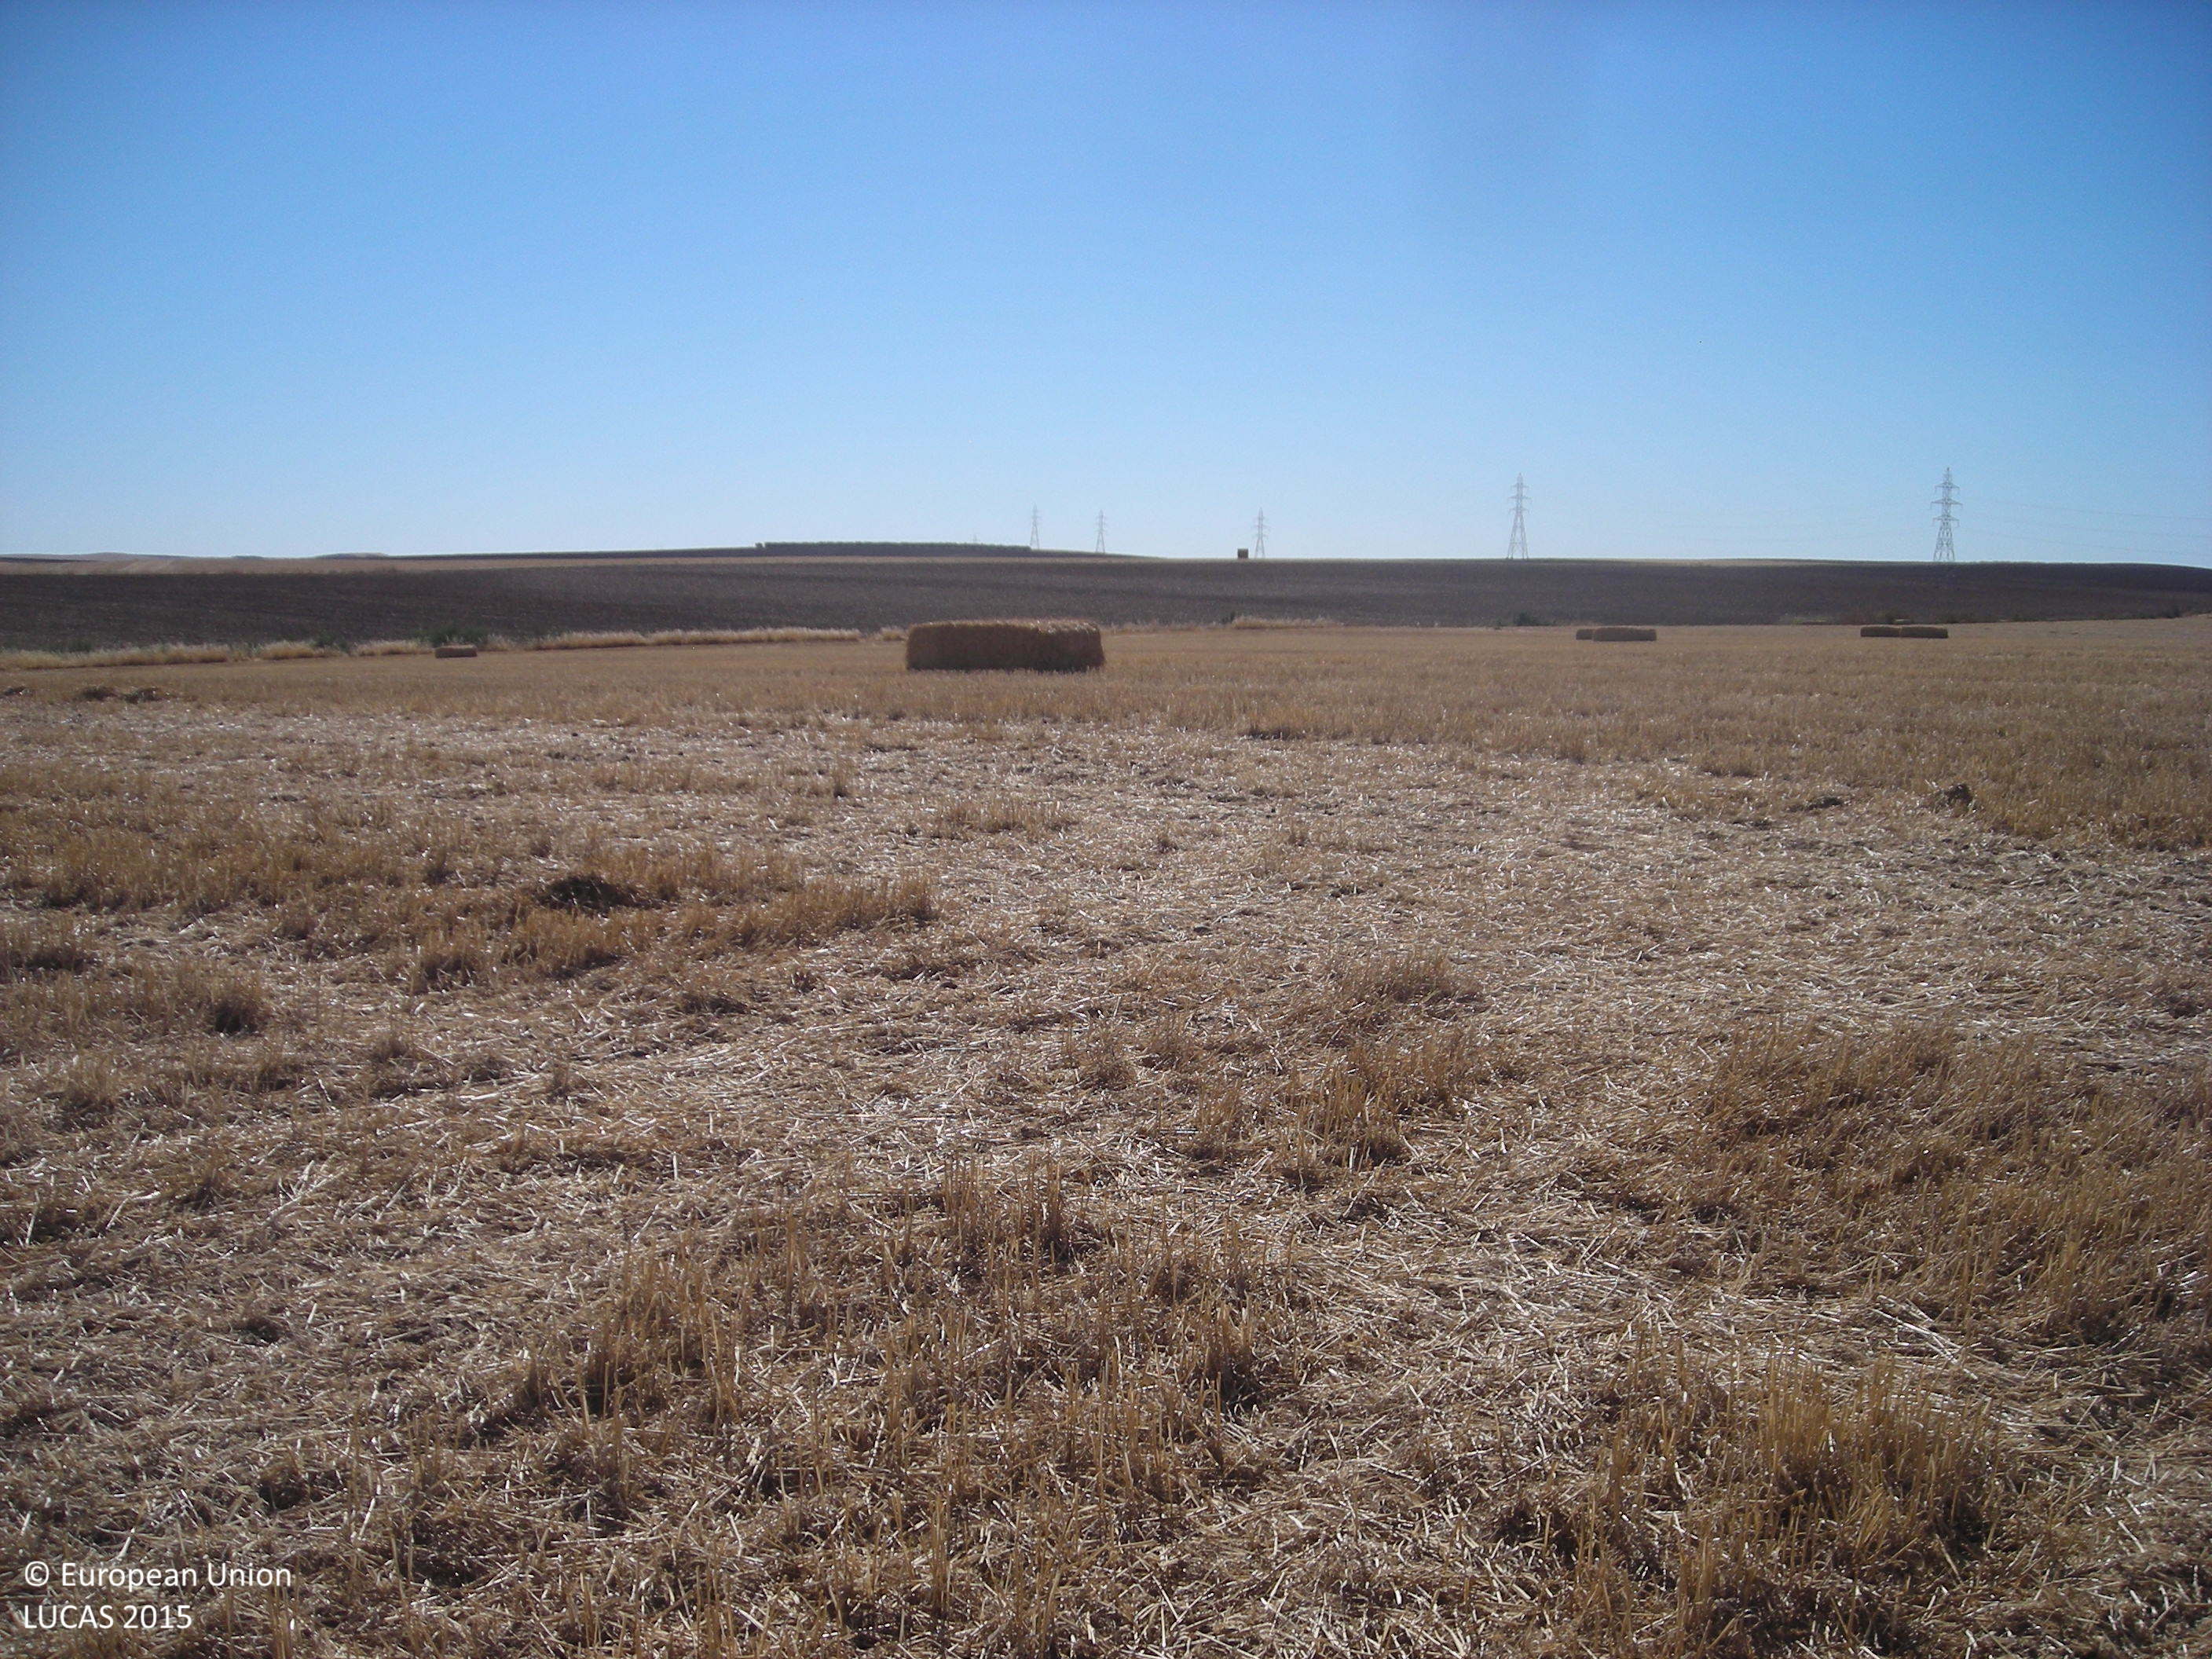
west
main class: Cropland
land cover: Common wheat
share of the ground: > 75 %
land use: Agriculture (excluding fallow land and kitchen gardens)
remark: Harvested field
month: July
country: ES
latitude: 38.9455
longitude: -5.7737
